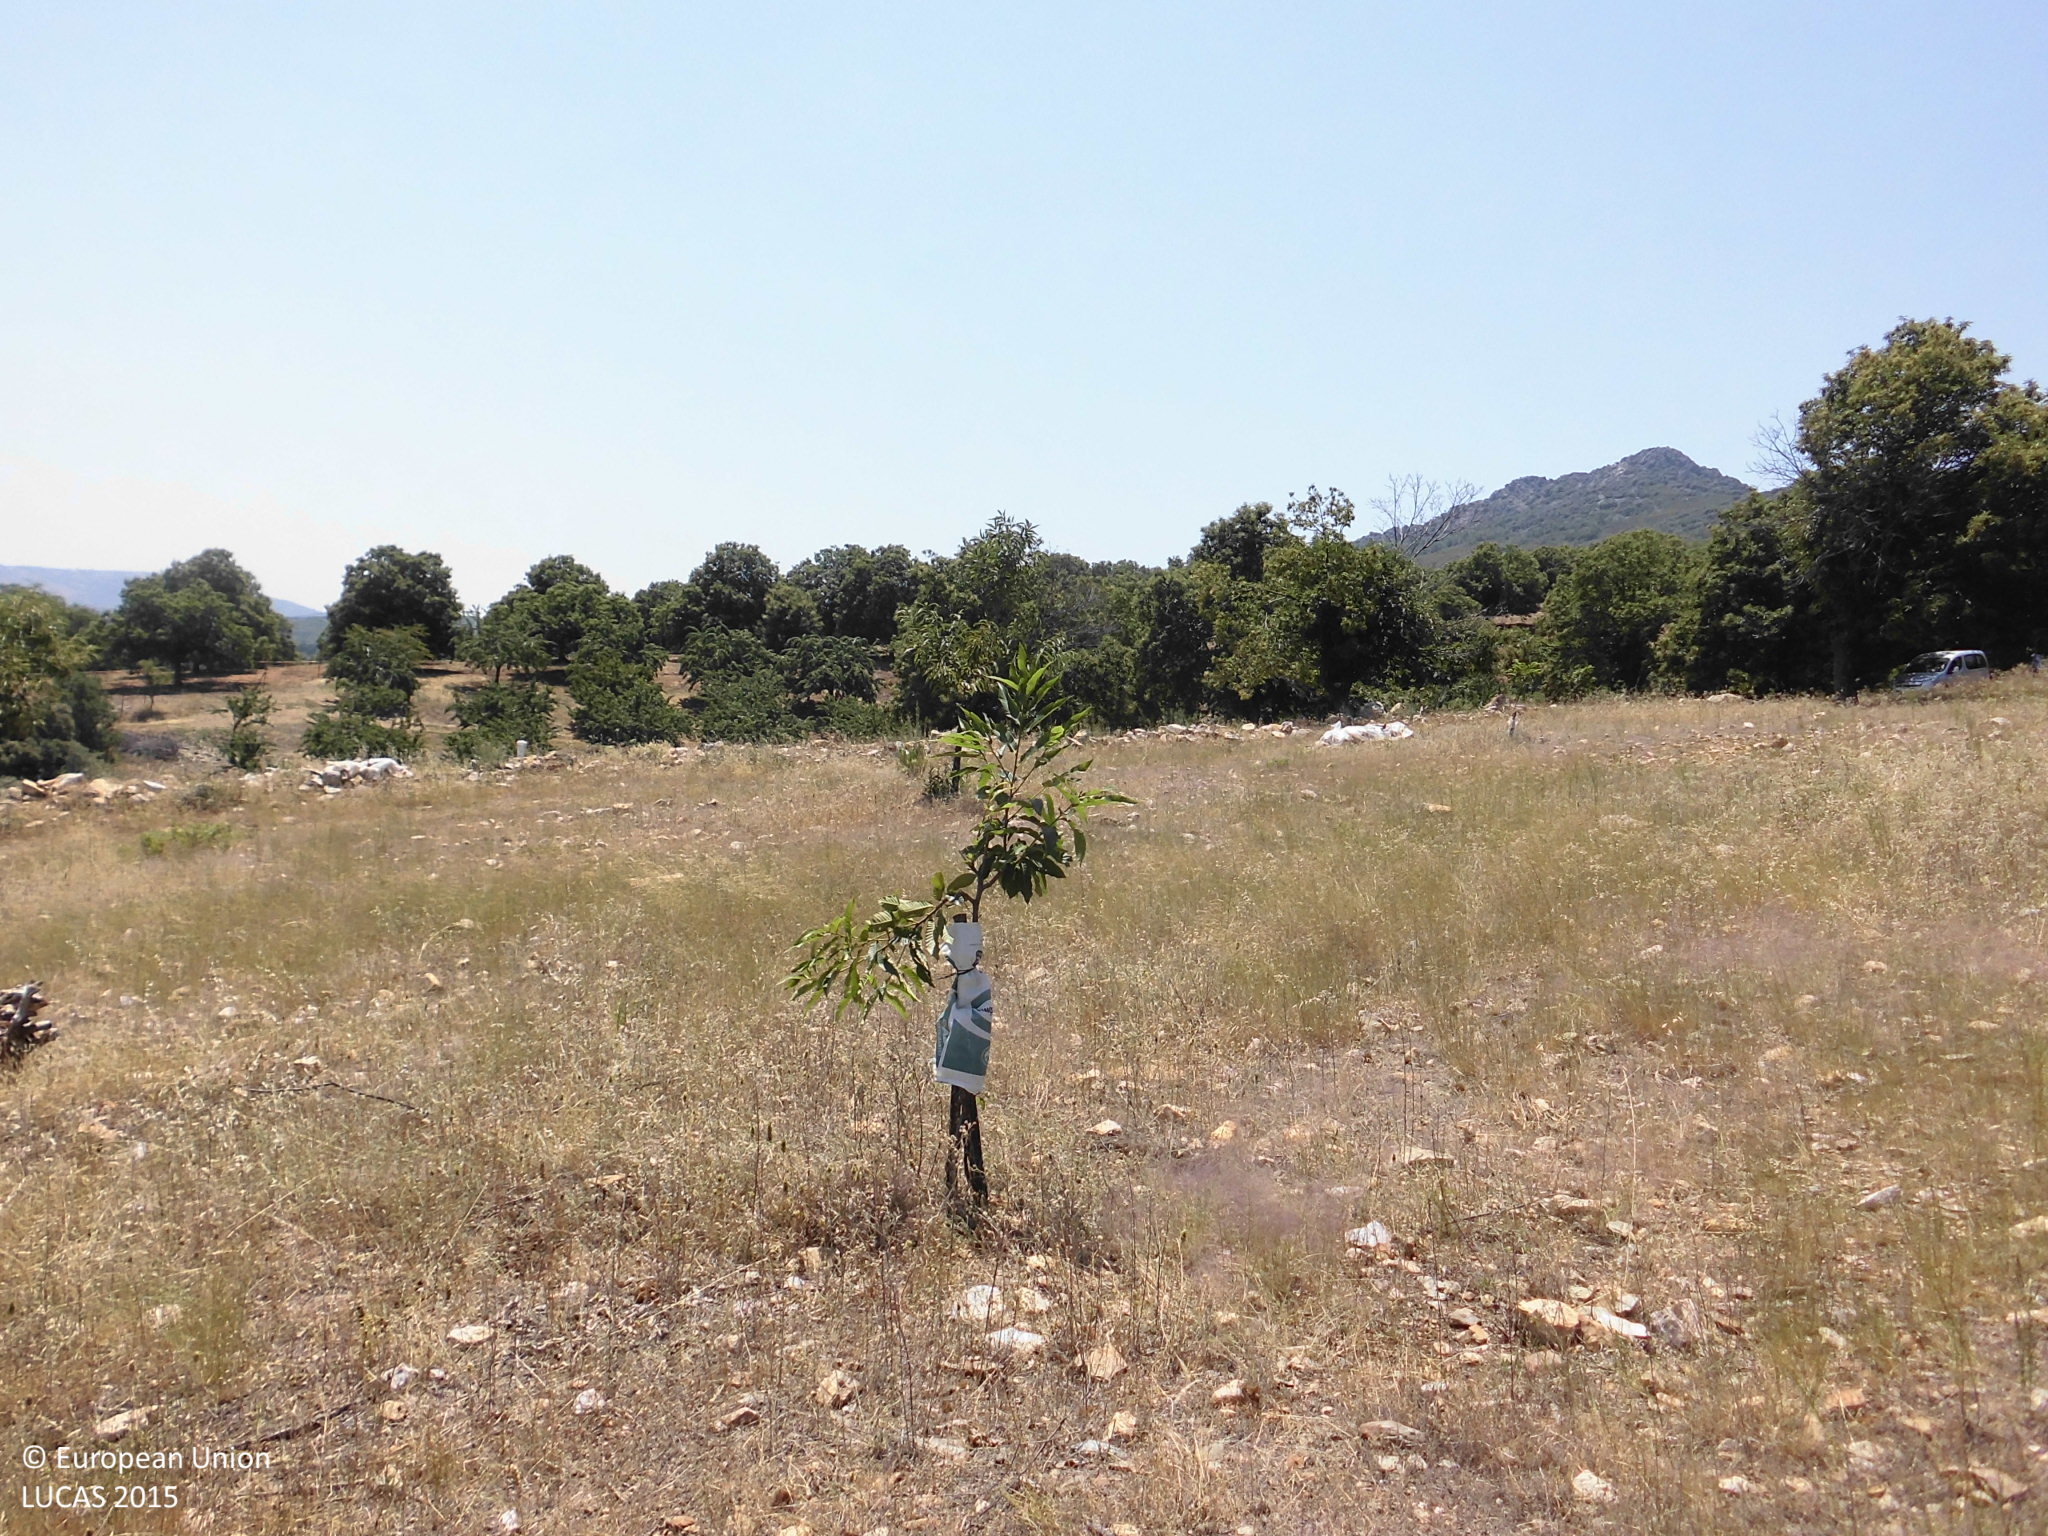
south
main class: Cropland
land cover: Nuts trees
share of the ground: 10 - 25 %
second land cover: Grassland without tree/shrub cover
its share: 50 - 75 %
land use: Agriculture (excluding fallow land and kitchen gardens)
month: June
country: ES
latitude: 39.5399
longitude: -5.3981
